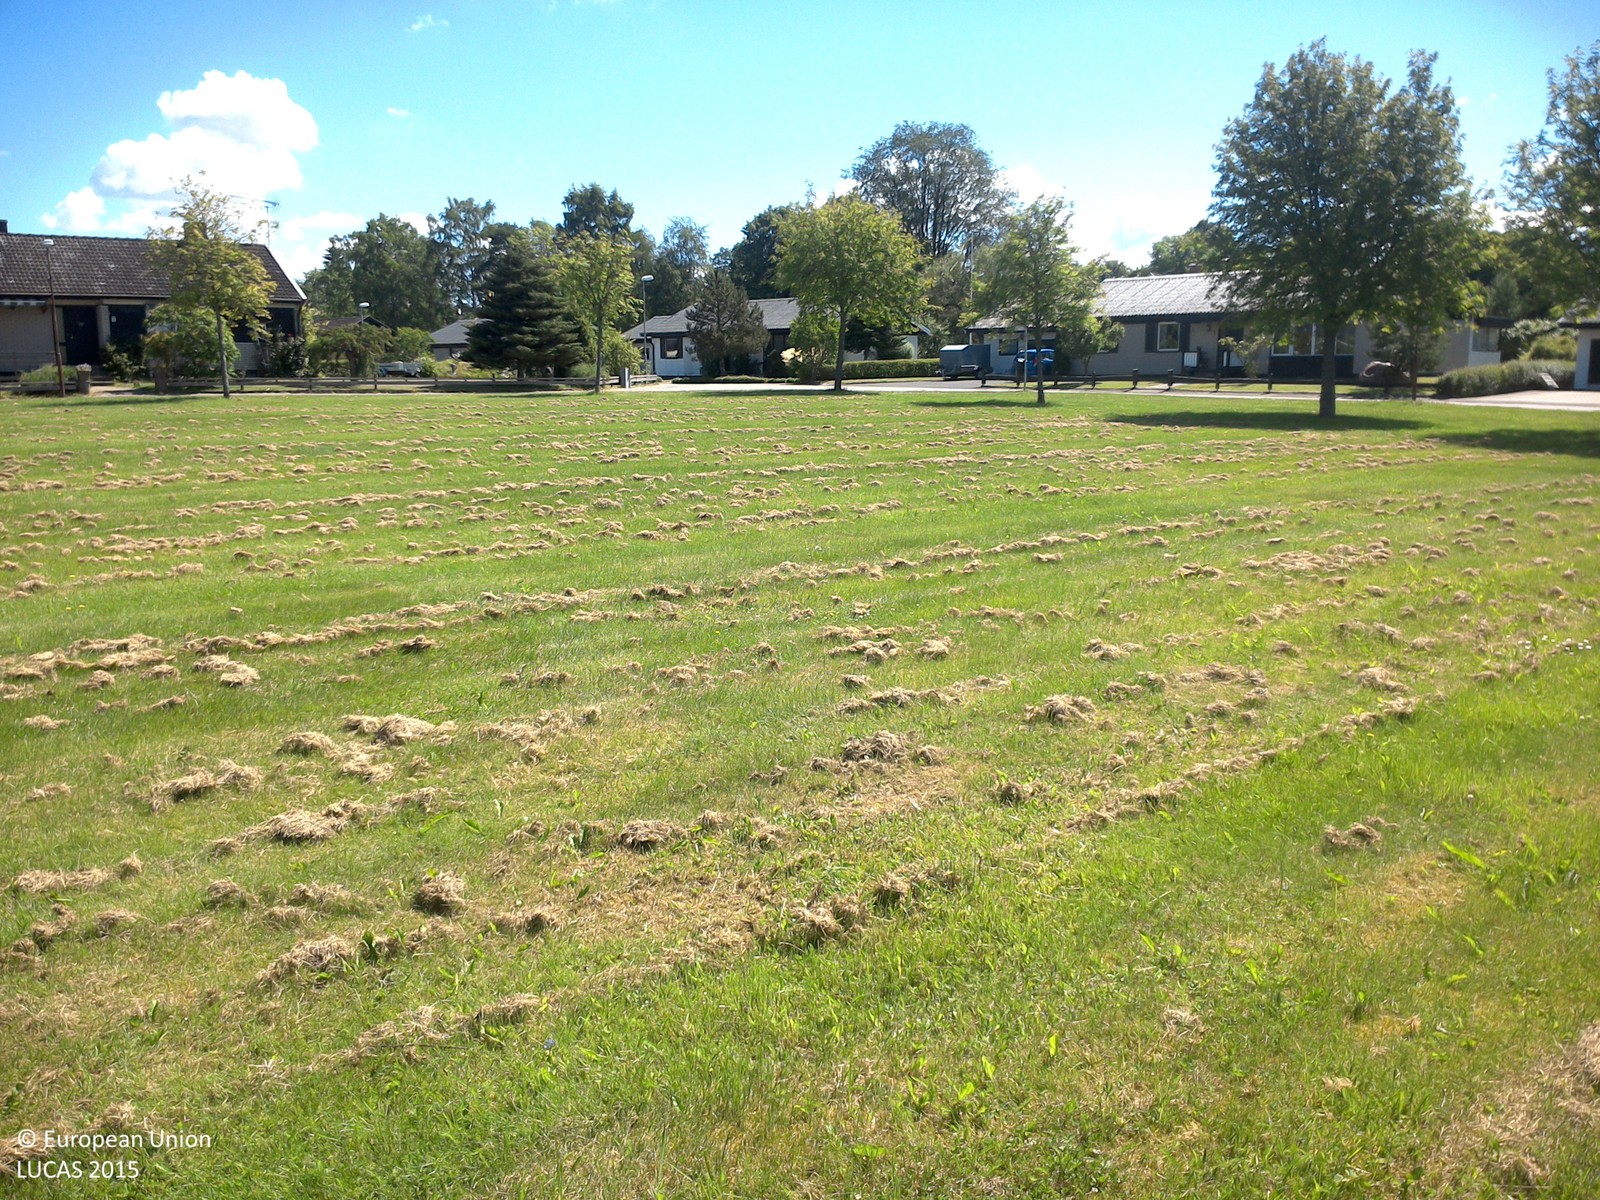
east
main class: Grassland
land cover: Grassland without tree/shrub cover
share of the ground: > 75 %
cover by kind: herbaceous plants 100 %
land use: Amenities, museums, leisure
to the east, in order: Grassland without tree/shrub cover; Lines of trees; Grassland without tree/shrub cover; Artificial constructions in urban areas; Grassland with sparse tree/shrub cover; Fences; Other mixed woodland; Fences; Other leguminous and mixtures for fodder; Groves
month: July
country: SE
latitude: 58.3989
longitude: 15.4182
